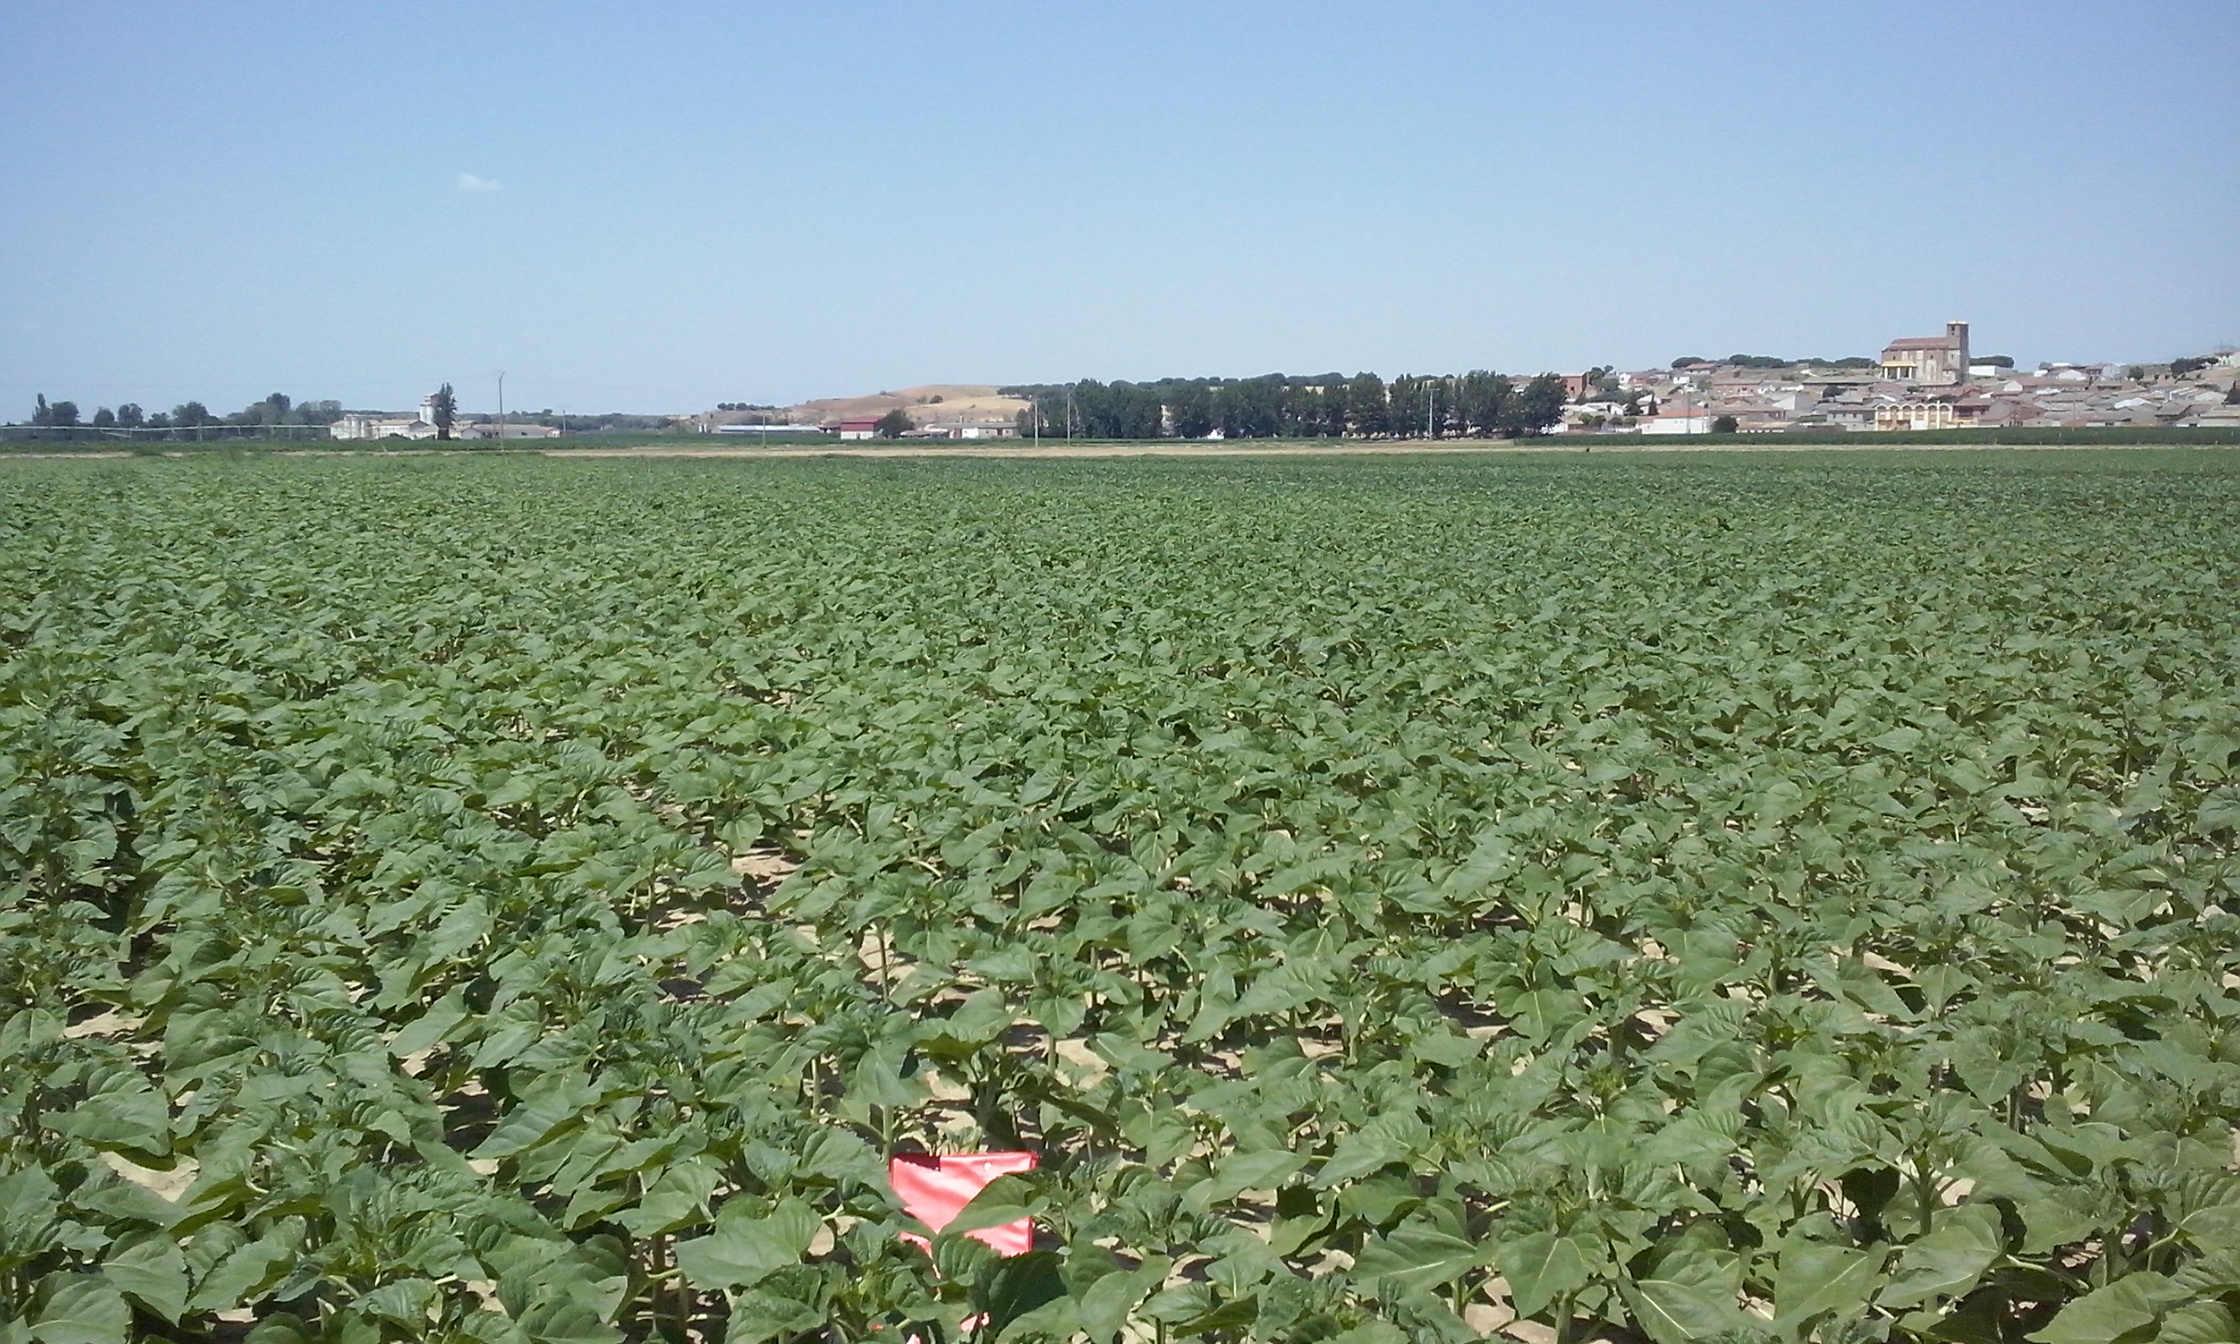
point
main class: Cropland
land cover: Sunflower
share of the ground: > 75 %
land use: Agriculture (excluding fallow land and kitchen gardens)
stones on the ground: < 10 %
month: June
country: ES
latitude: 41.4809
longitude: -5.0791
